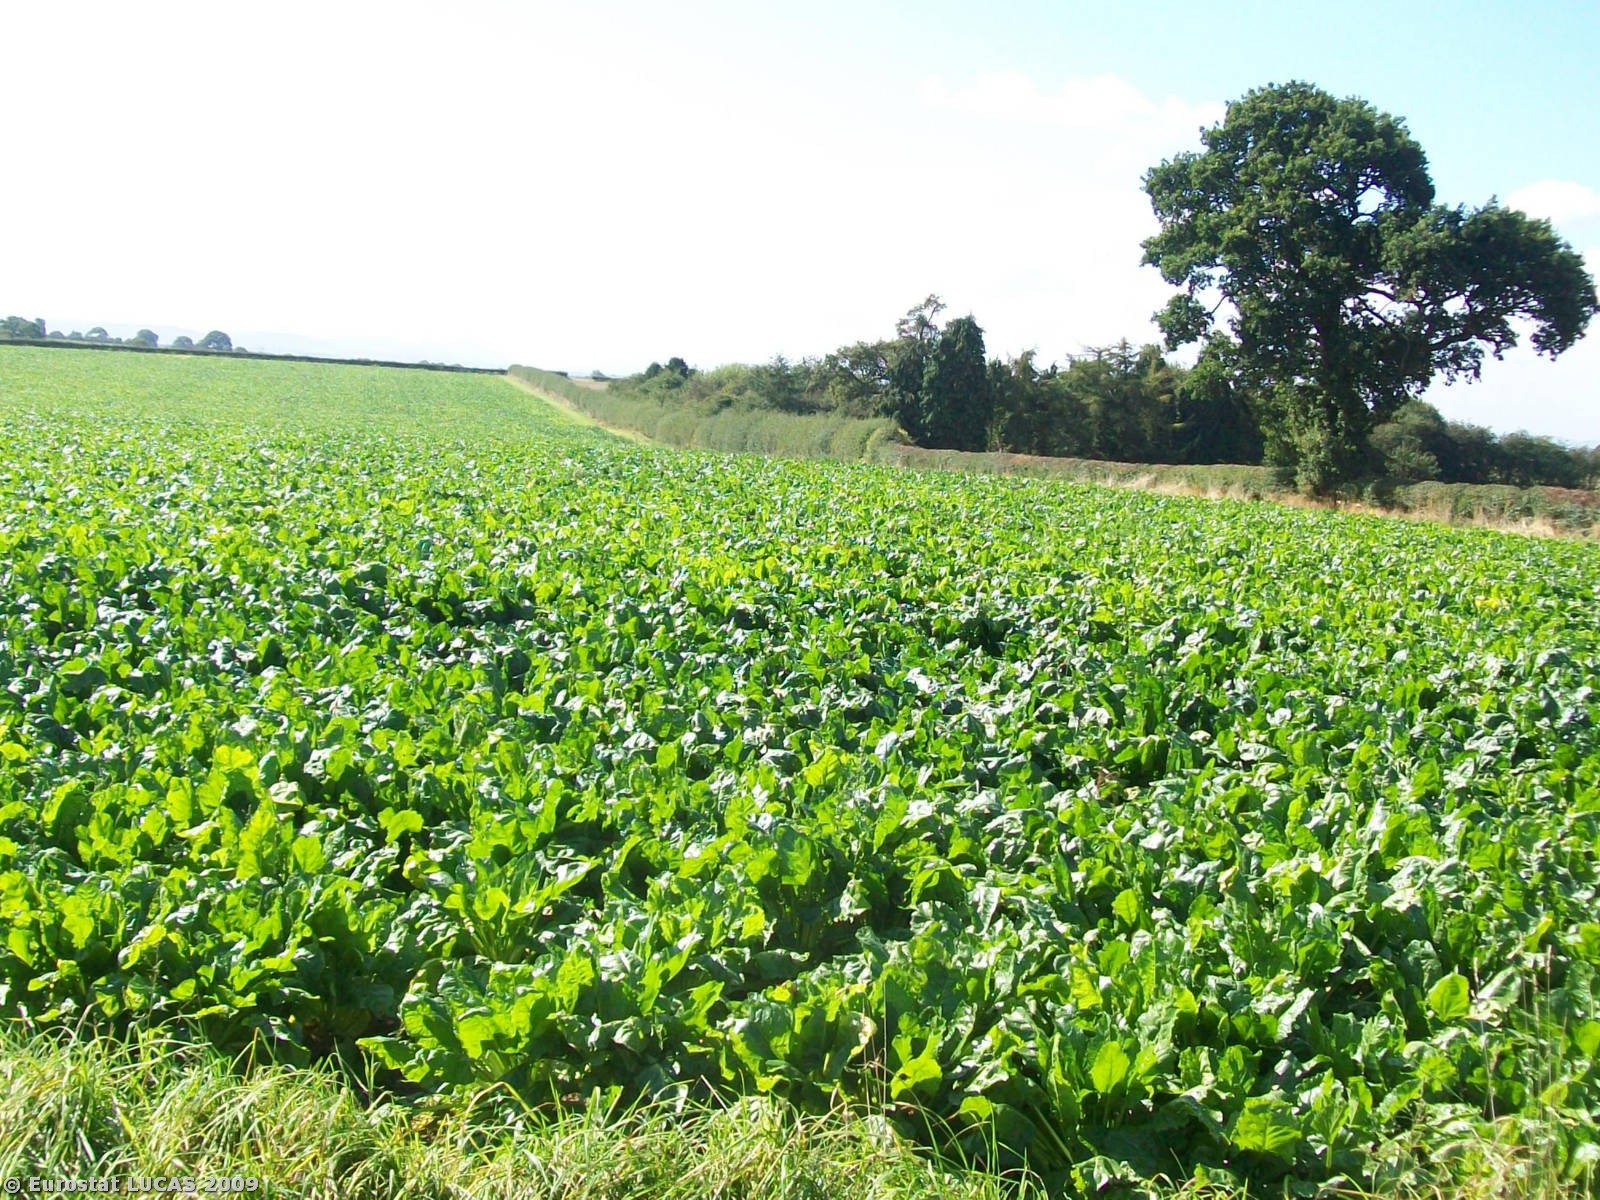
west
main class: Cropland
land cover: Sugar beet
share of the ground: > 75 %
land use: Agriculture (excluding fallow land and kitchen gardens)
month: September
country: GB
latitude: 52.7422
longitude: -2.5840
